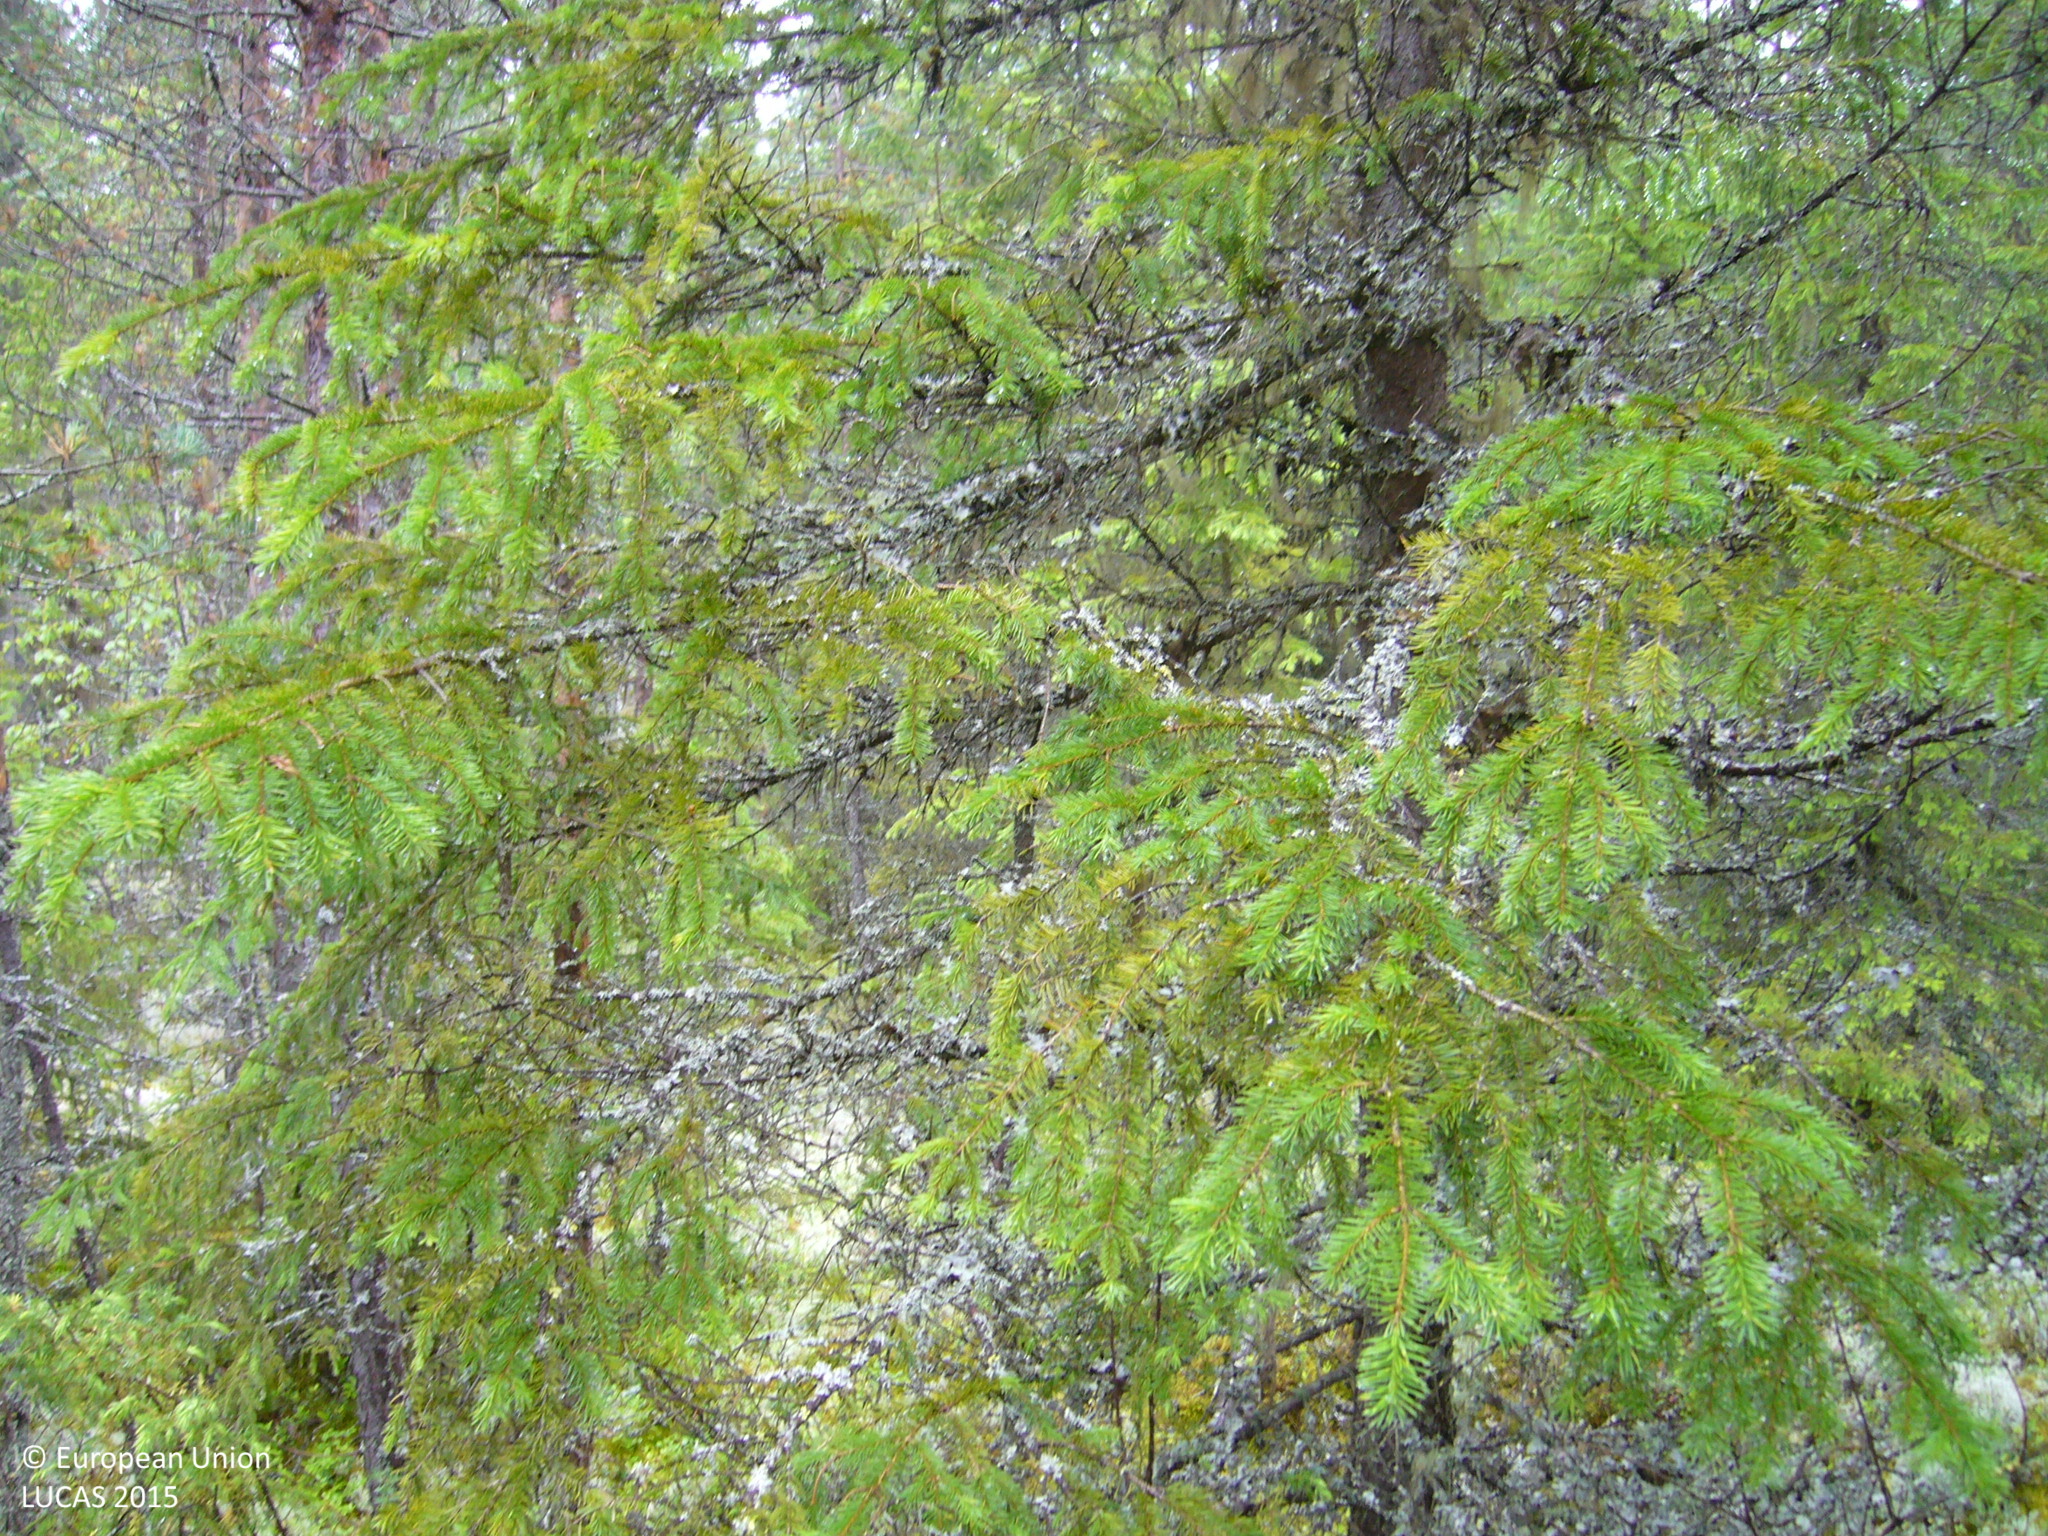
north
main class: Woodland
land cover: Spruce dominated coniferous woodland
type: boreal forest
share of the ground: 50 - 75 %
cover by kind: coniferous forest trees 60 %, lichens and mosses 40 %
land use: Forestry
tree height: > 5 m
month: July
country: FI
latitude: 63.6221
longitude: 25.5753
